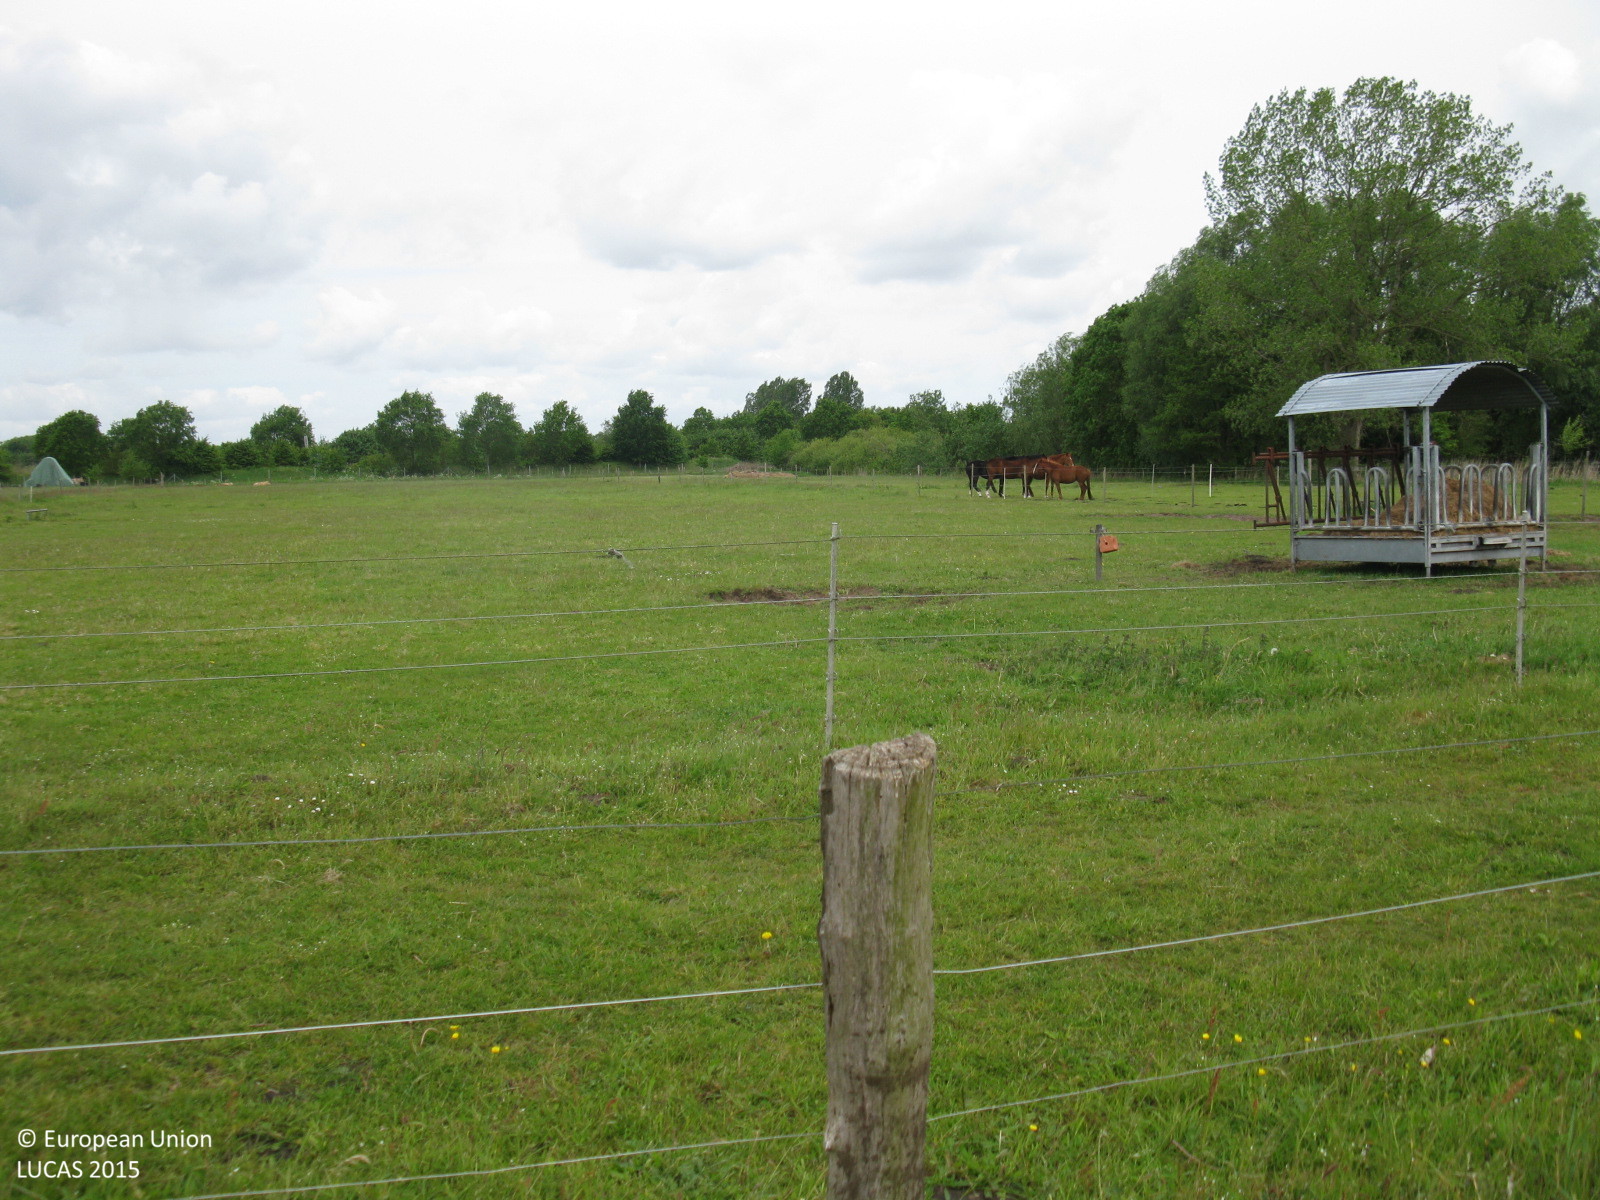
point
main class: Grassland
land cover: Grassland without tree/shrub cover
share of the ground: > 75 %
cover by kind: herbaceous plants 100 %
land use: Agriculture (excluding fallow land and kitchen gardens)
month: June
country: DE
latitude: 53.1739
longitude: 7.2926
